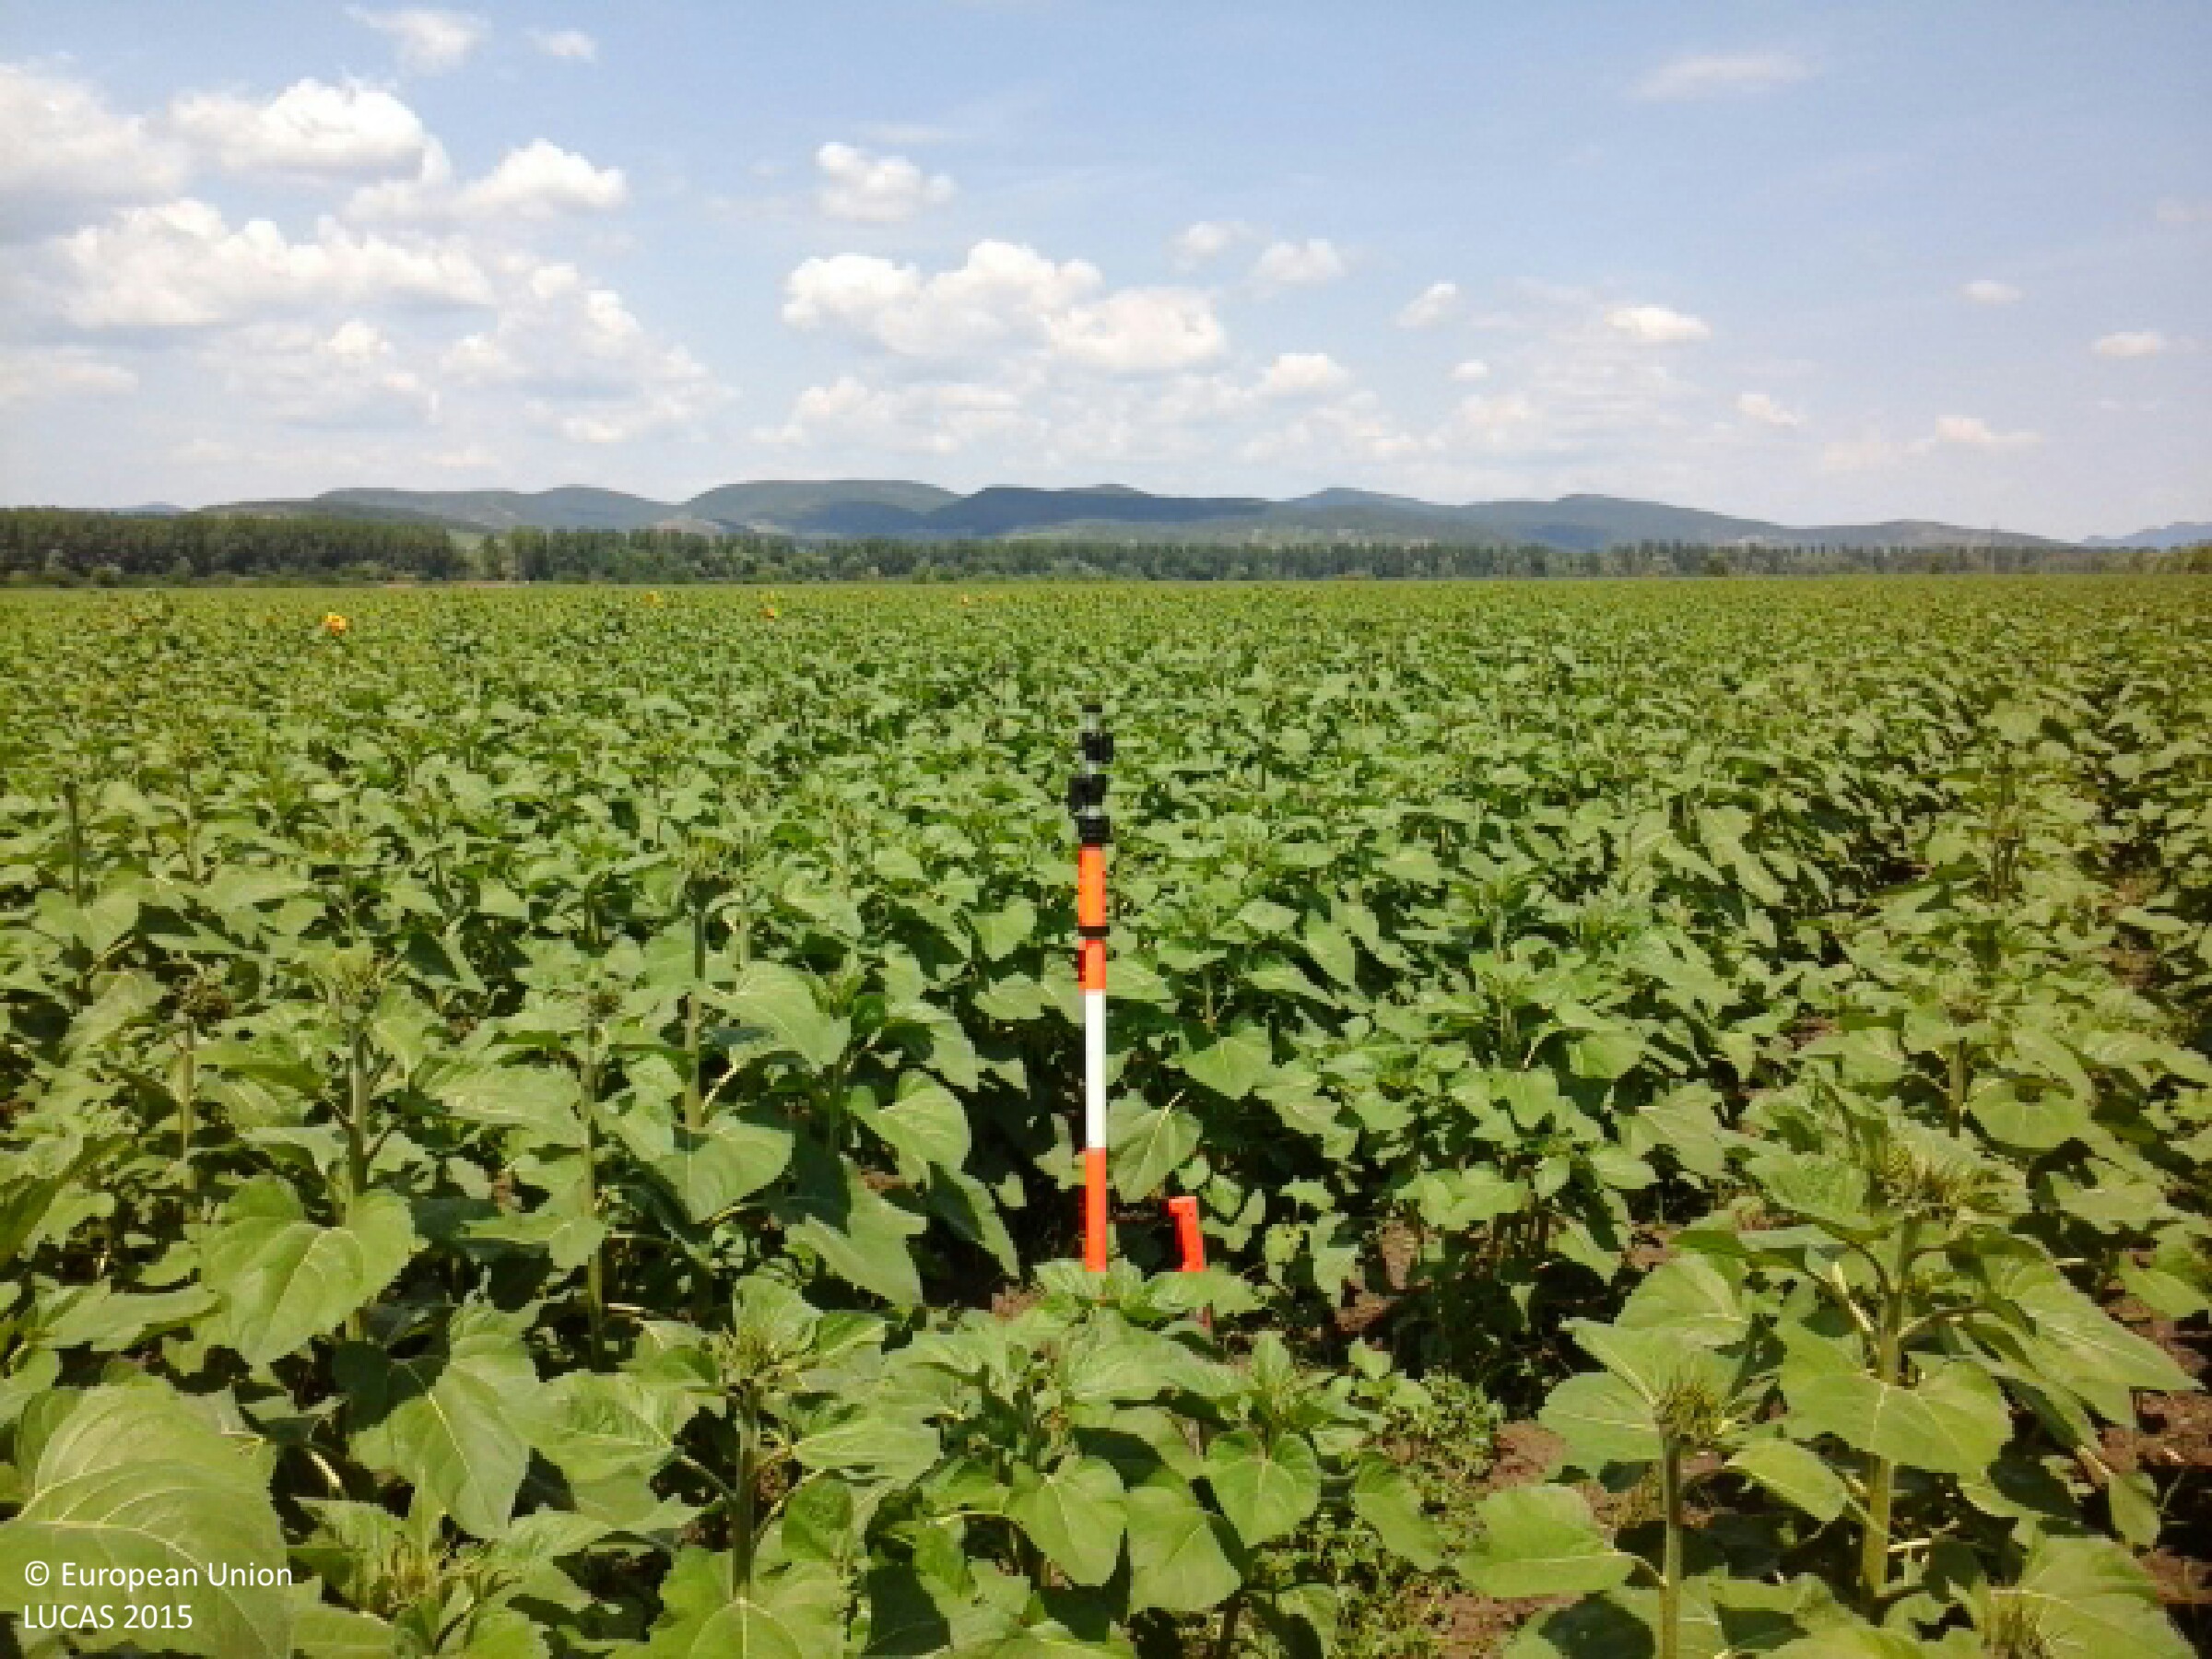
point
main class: Cropland
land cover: Sunflower
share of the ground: > 75 %
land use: Agriculture (excluding fallow land and kitchen gardens)
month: July
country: HU
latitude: 48.2547
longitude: 21.5083
